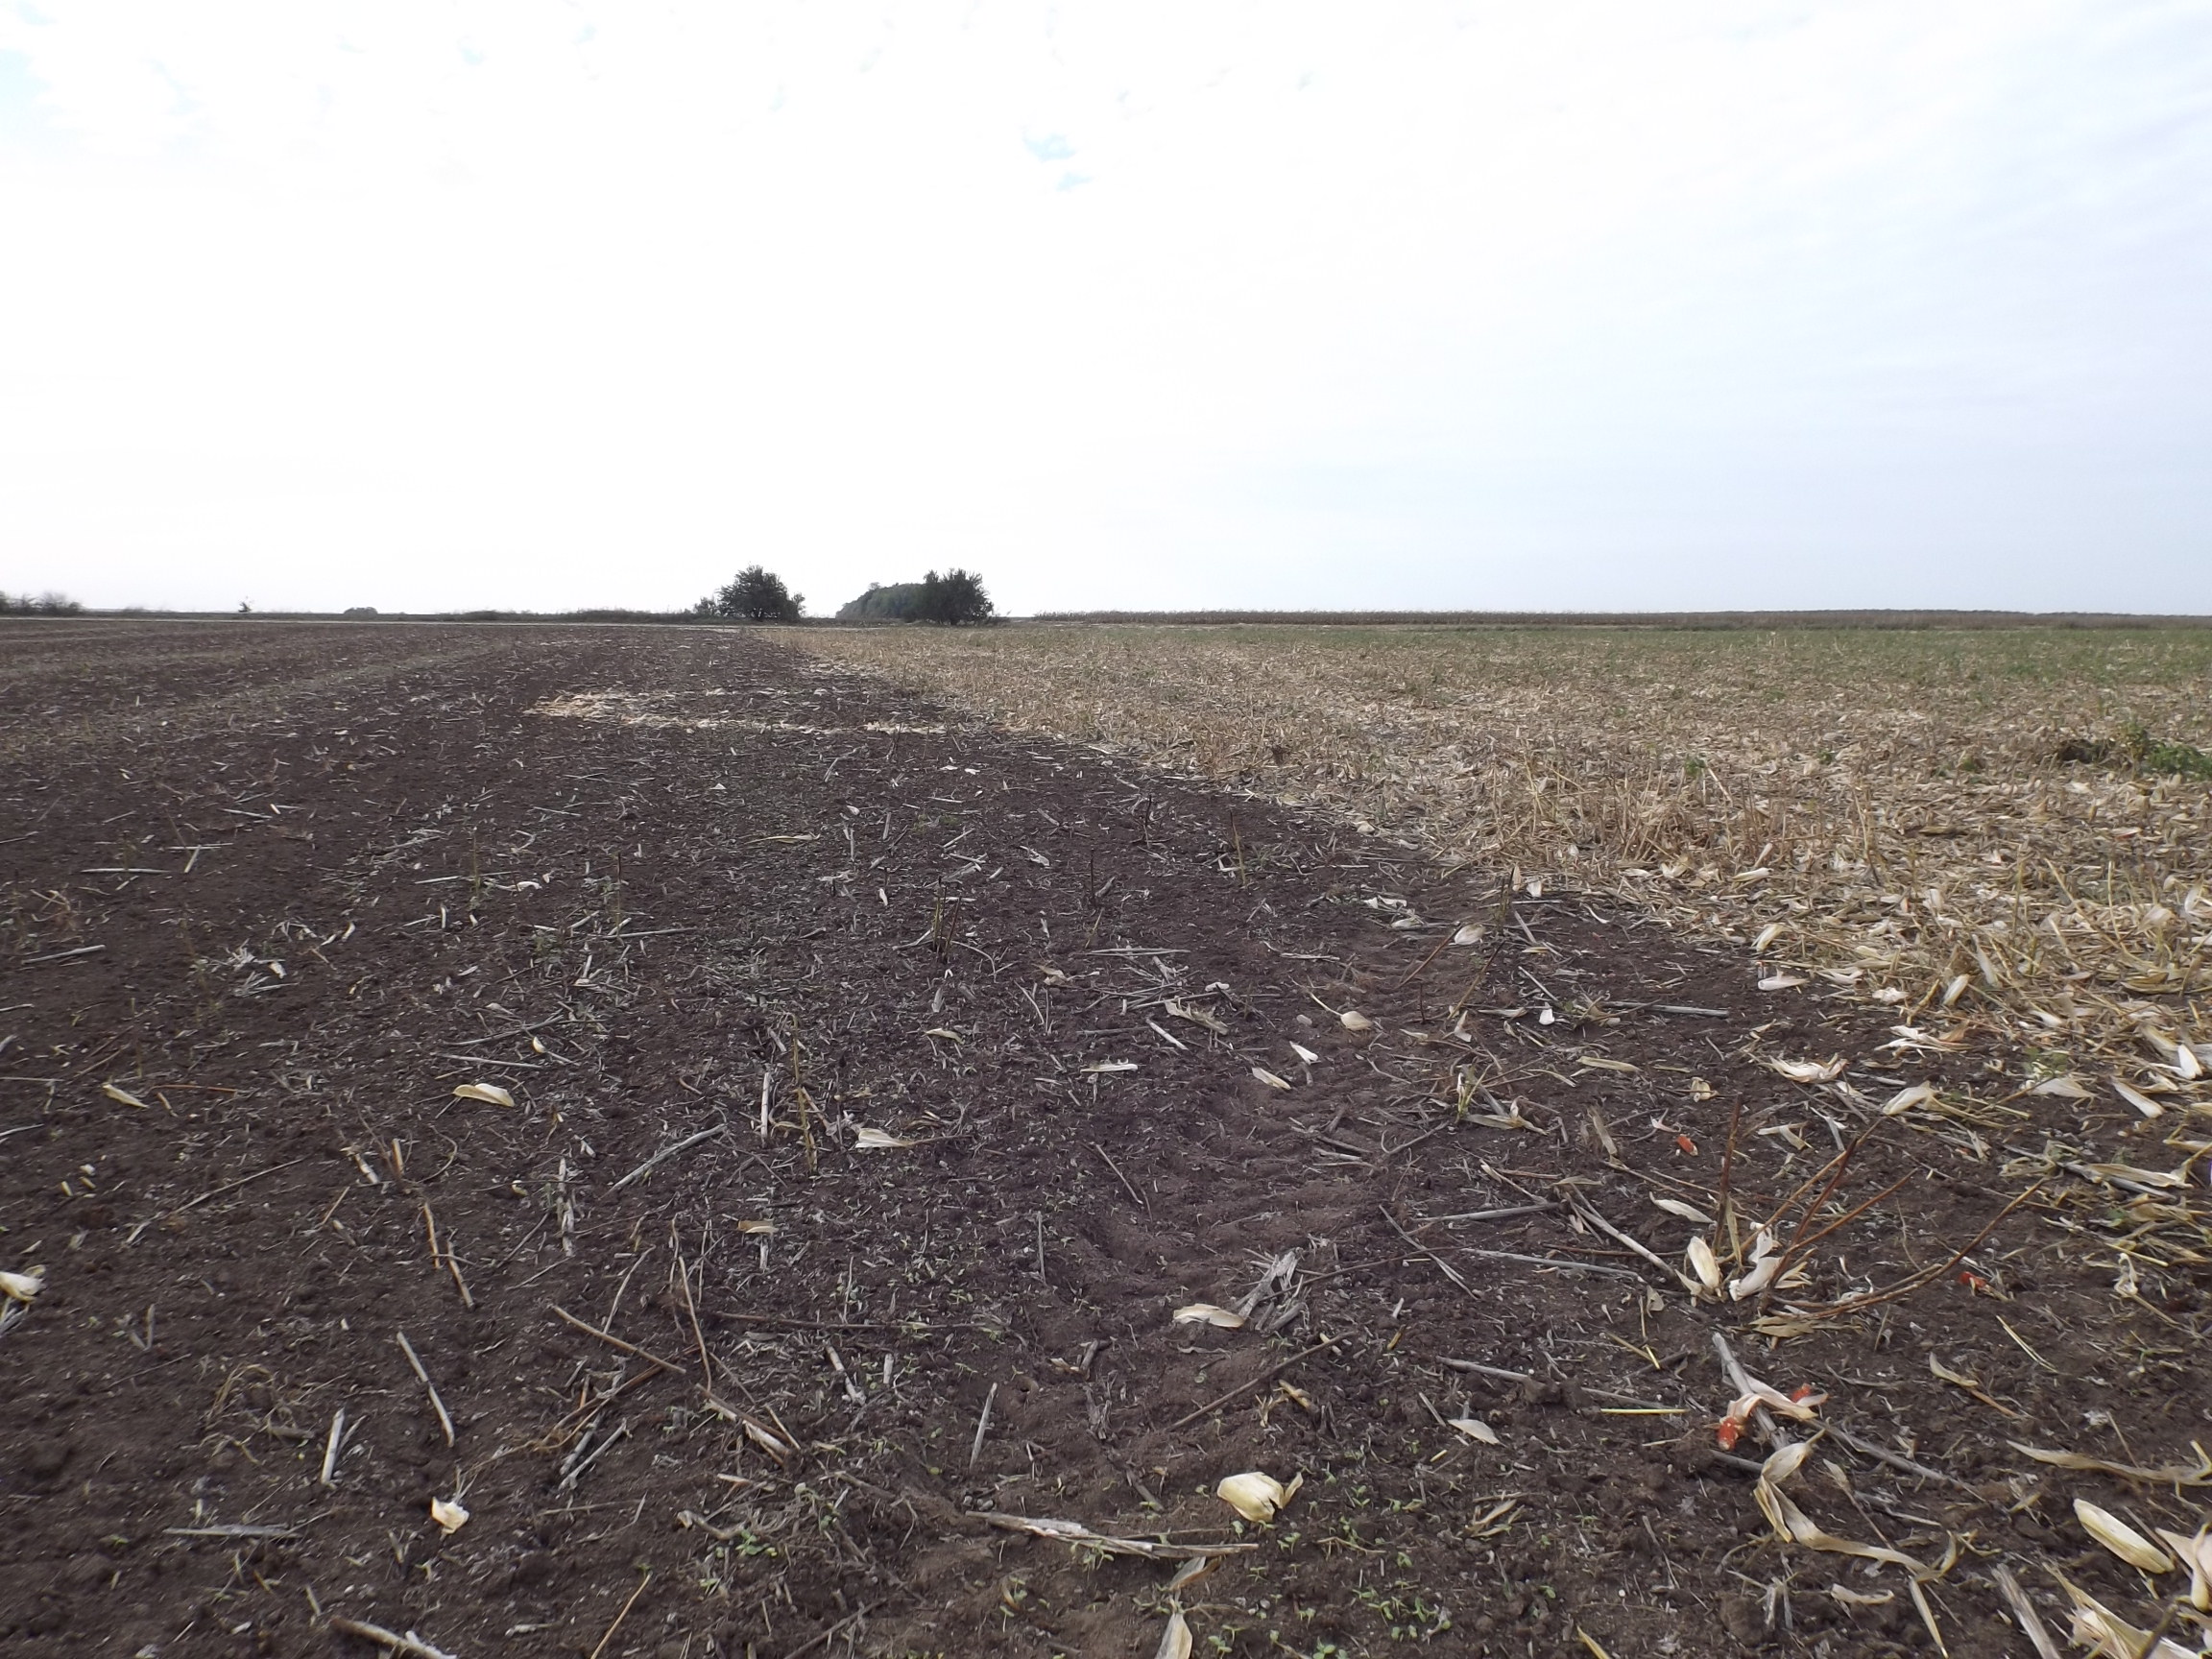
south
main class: Cropland
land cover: Sunflower
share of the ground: < 10 %
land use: Agriculture (excluding fallow land and kitchen gardens)
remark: Harvested field
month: October
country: BG
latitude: 43.9491
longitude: 26.8785
